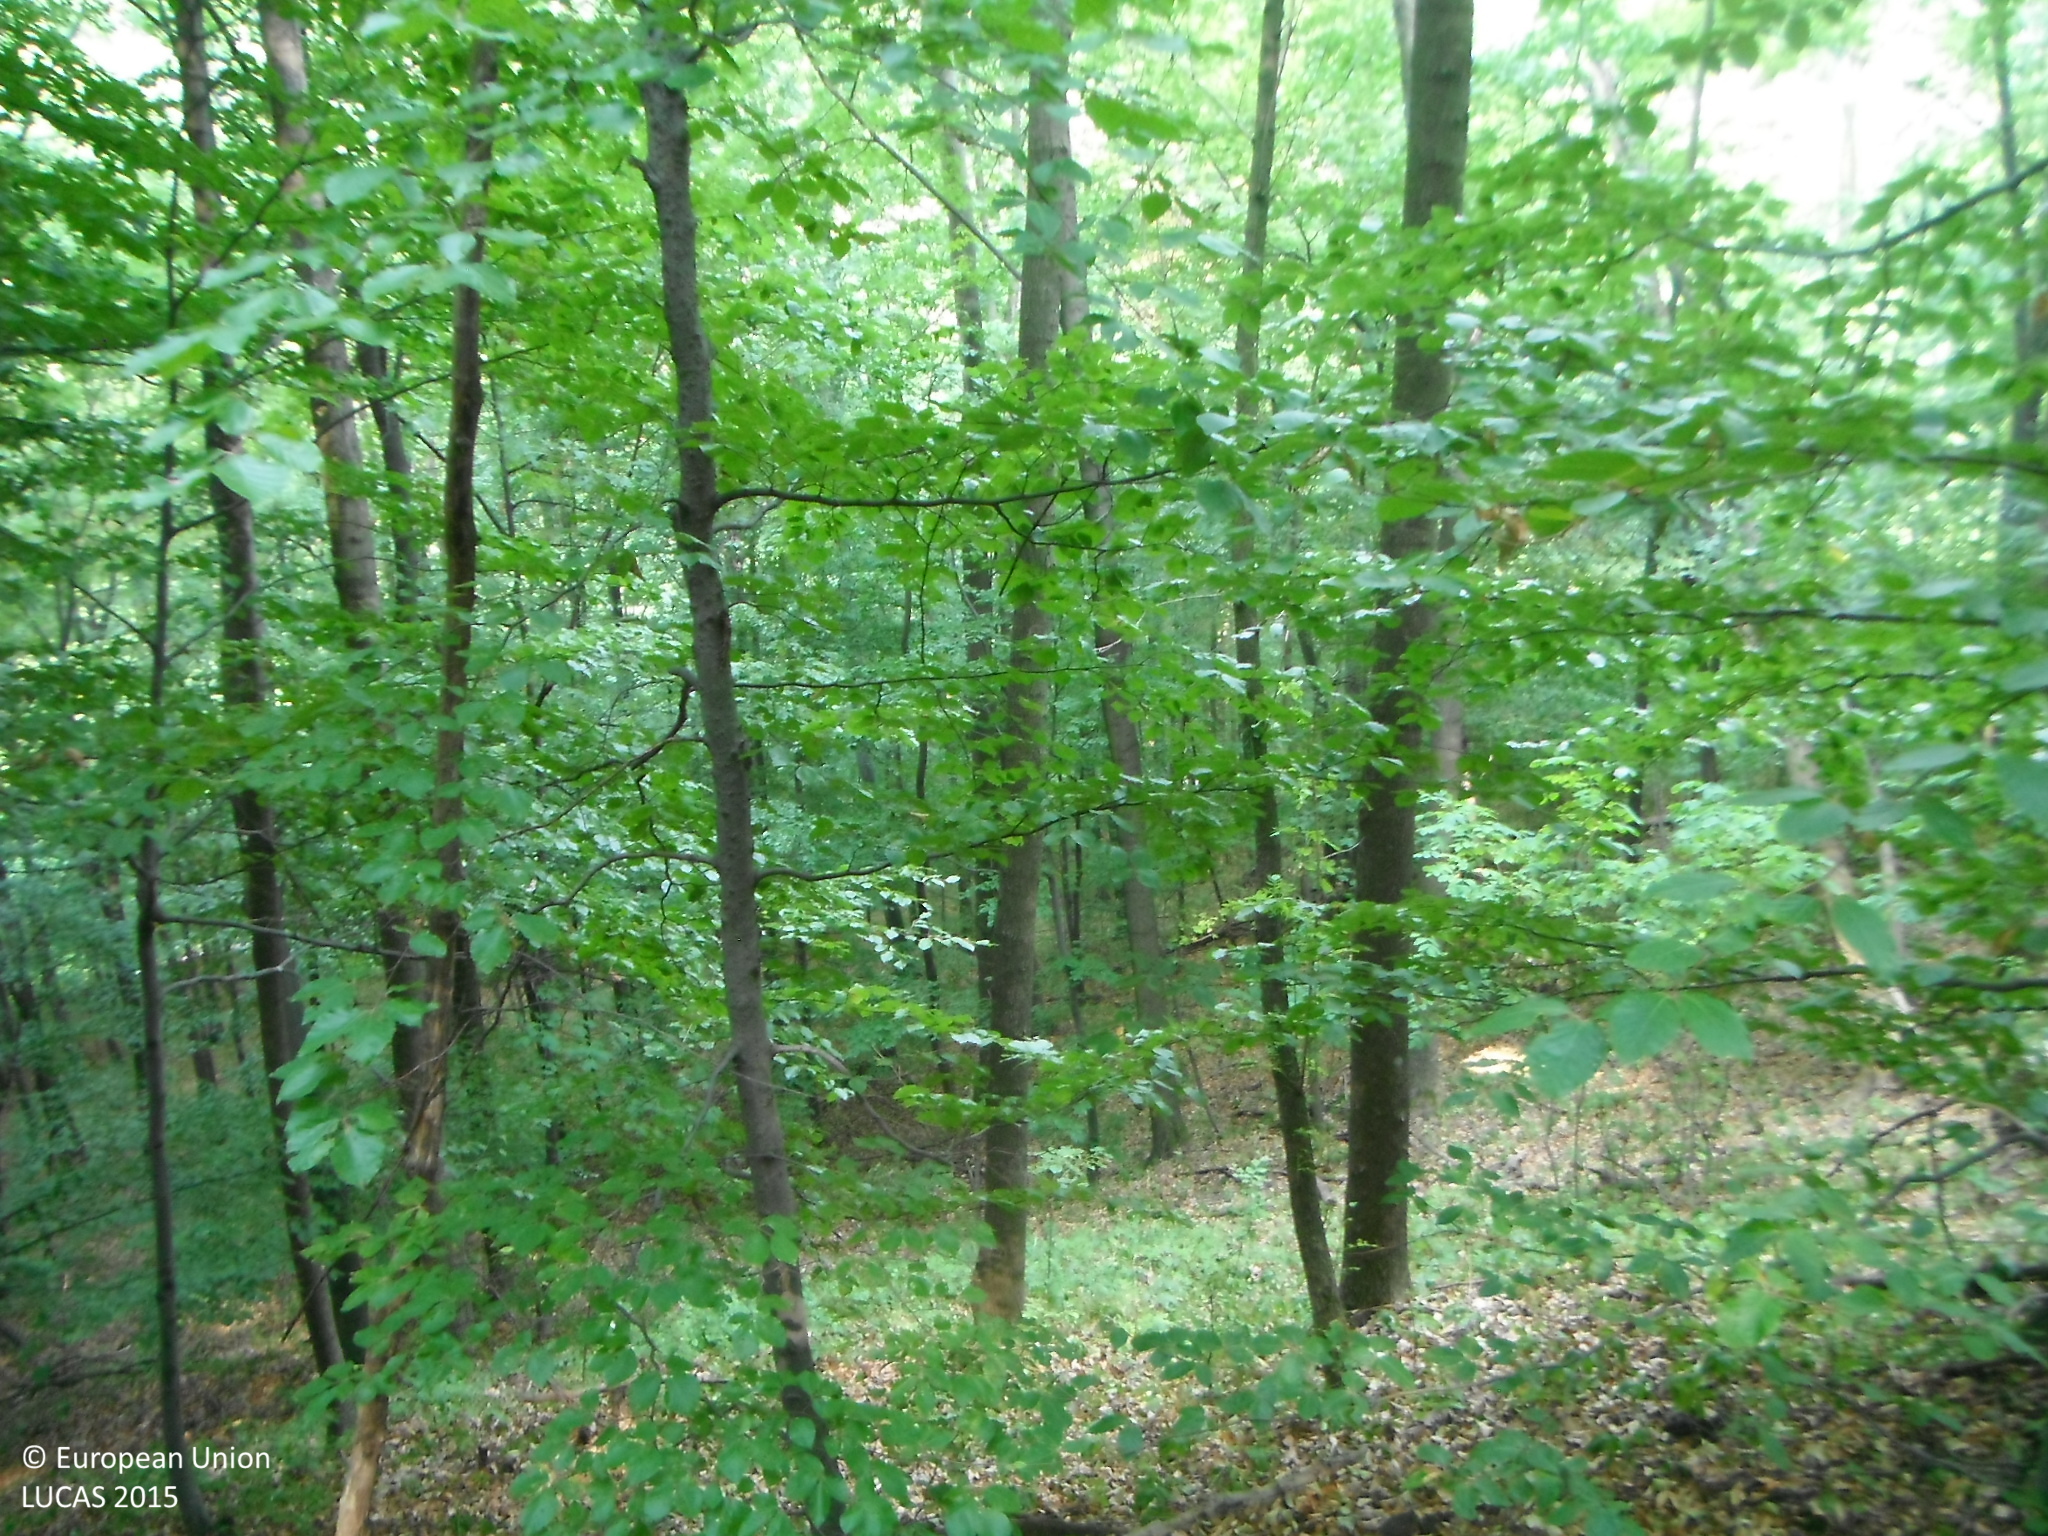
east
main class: Woodland
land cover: Broadleaved woodland
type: beech forest
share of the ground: > 75 %
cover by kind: broadleaved forest trees 80 %, shrubs 10 %, herbaceous plants 10 %
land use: Forestry
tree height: > 5 m
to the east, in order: Broadleaved woodland; Tracks; Broadleaved woodland; Shrubland with sparse tree cover; Shrubland without tree cover; Broadleaved woodland
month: August
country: SK
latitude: 48.6787
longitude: 17.9315
